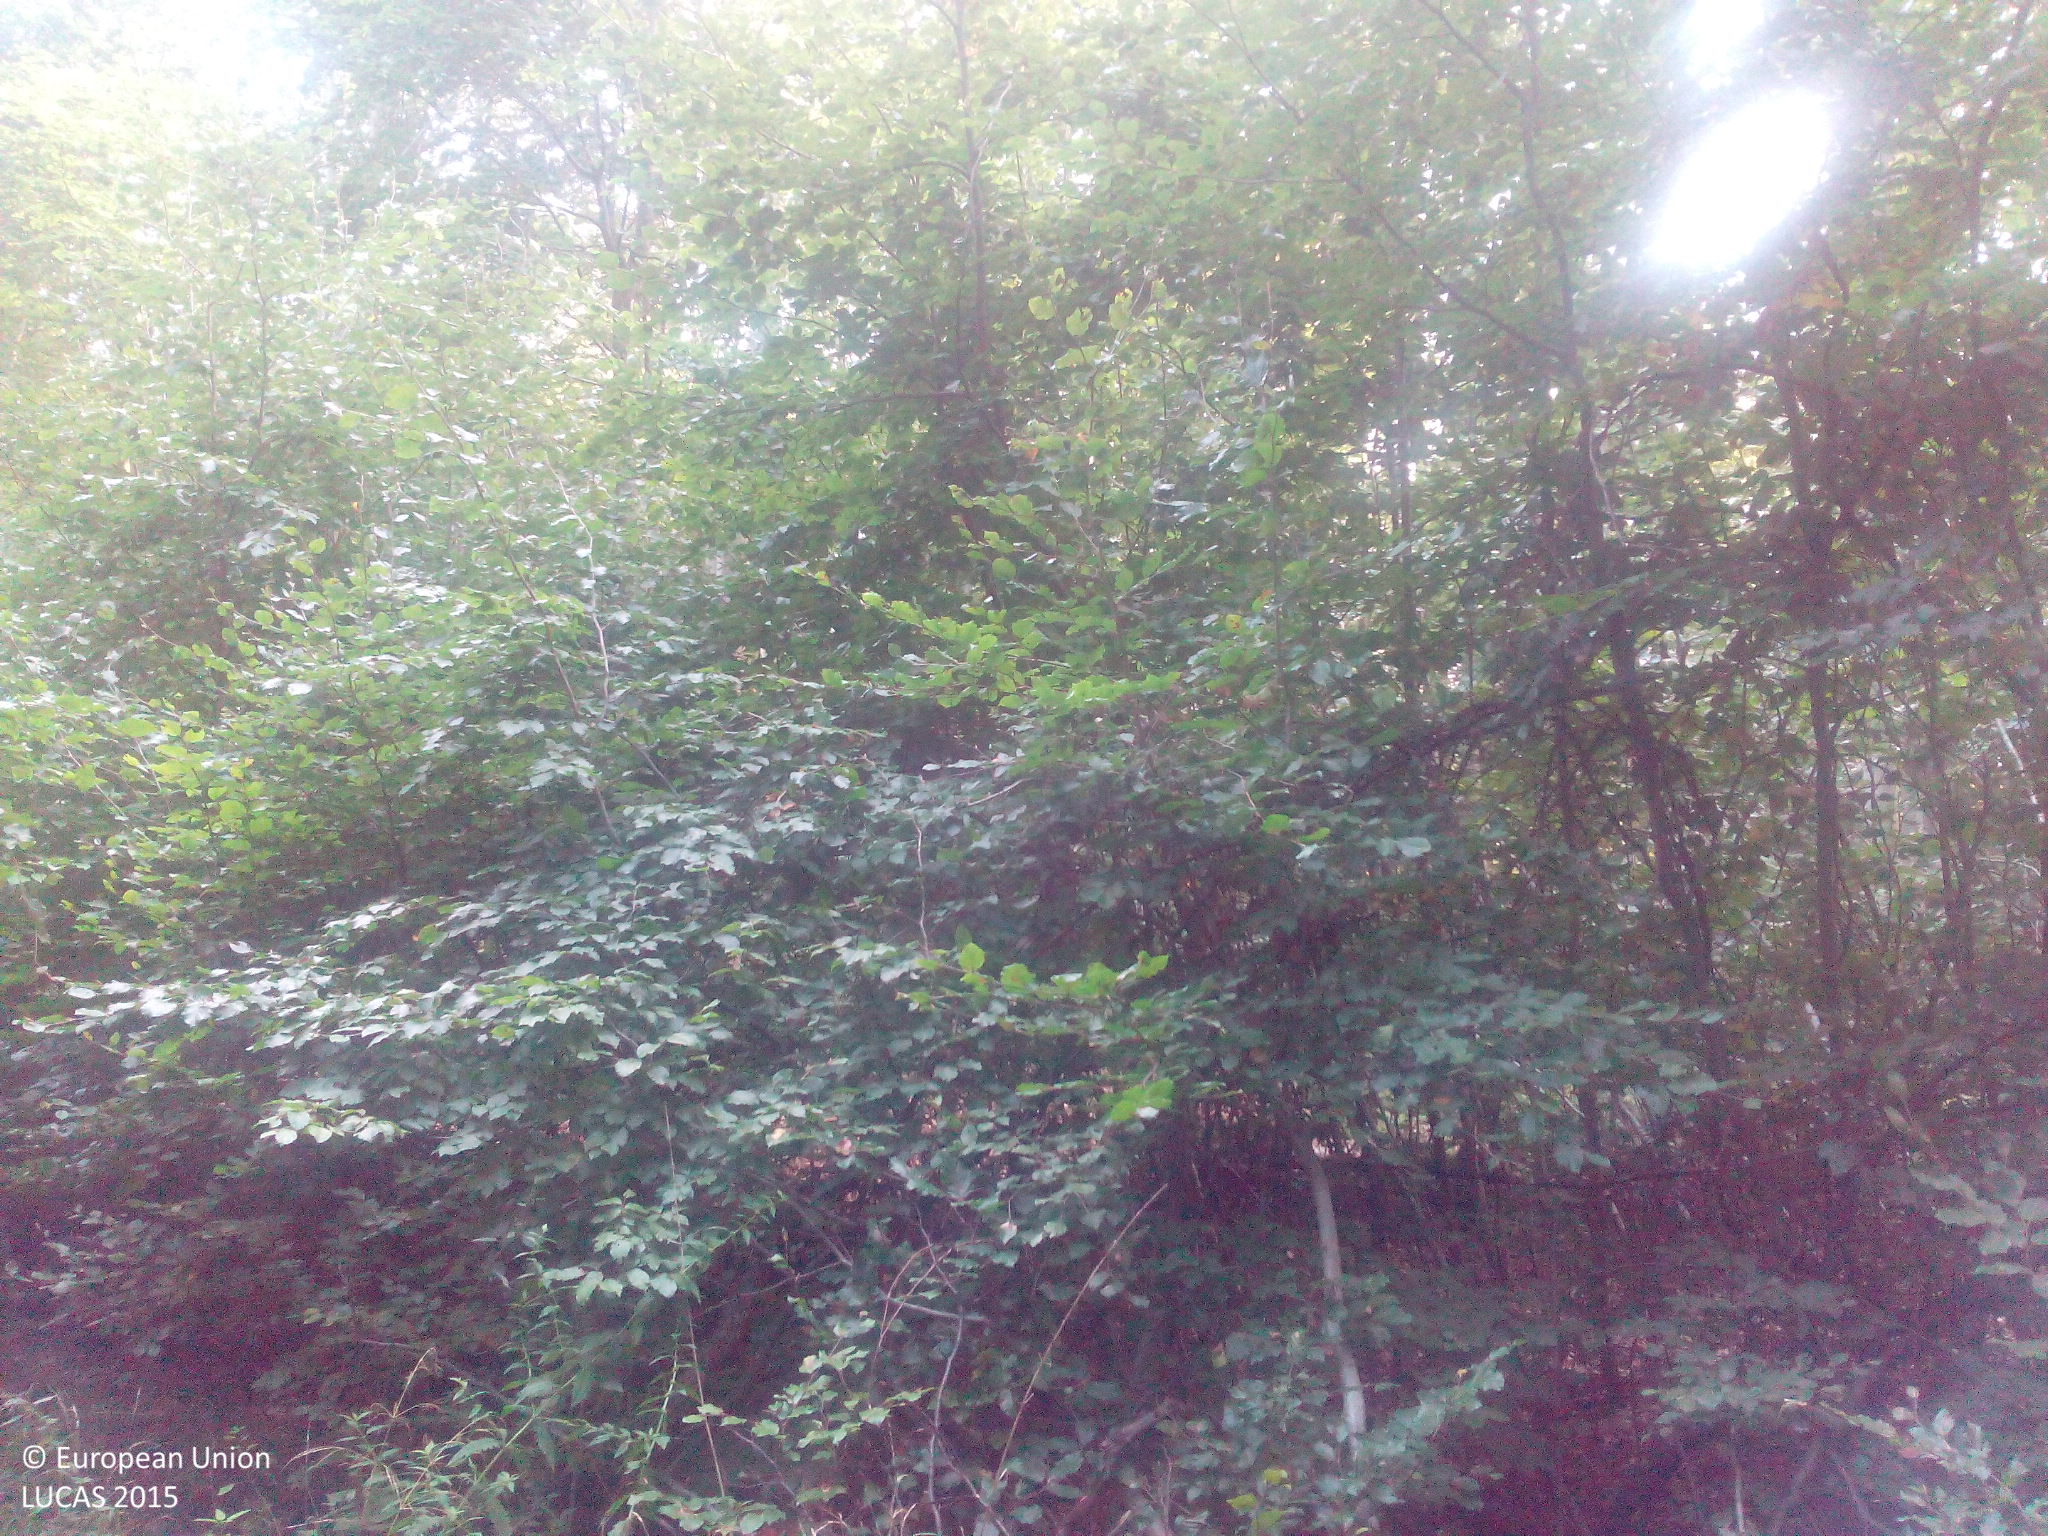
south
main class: Woodland
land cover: Broadleaved woodland
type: beech forest
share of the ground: > 75 %
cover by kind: broadleaved forest trees 100 %
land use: Forestry
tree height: > 5 m
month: September
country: DE
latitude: 51.3839
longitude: 11.0774
